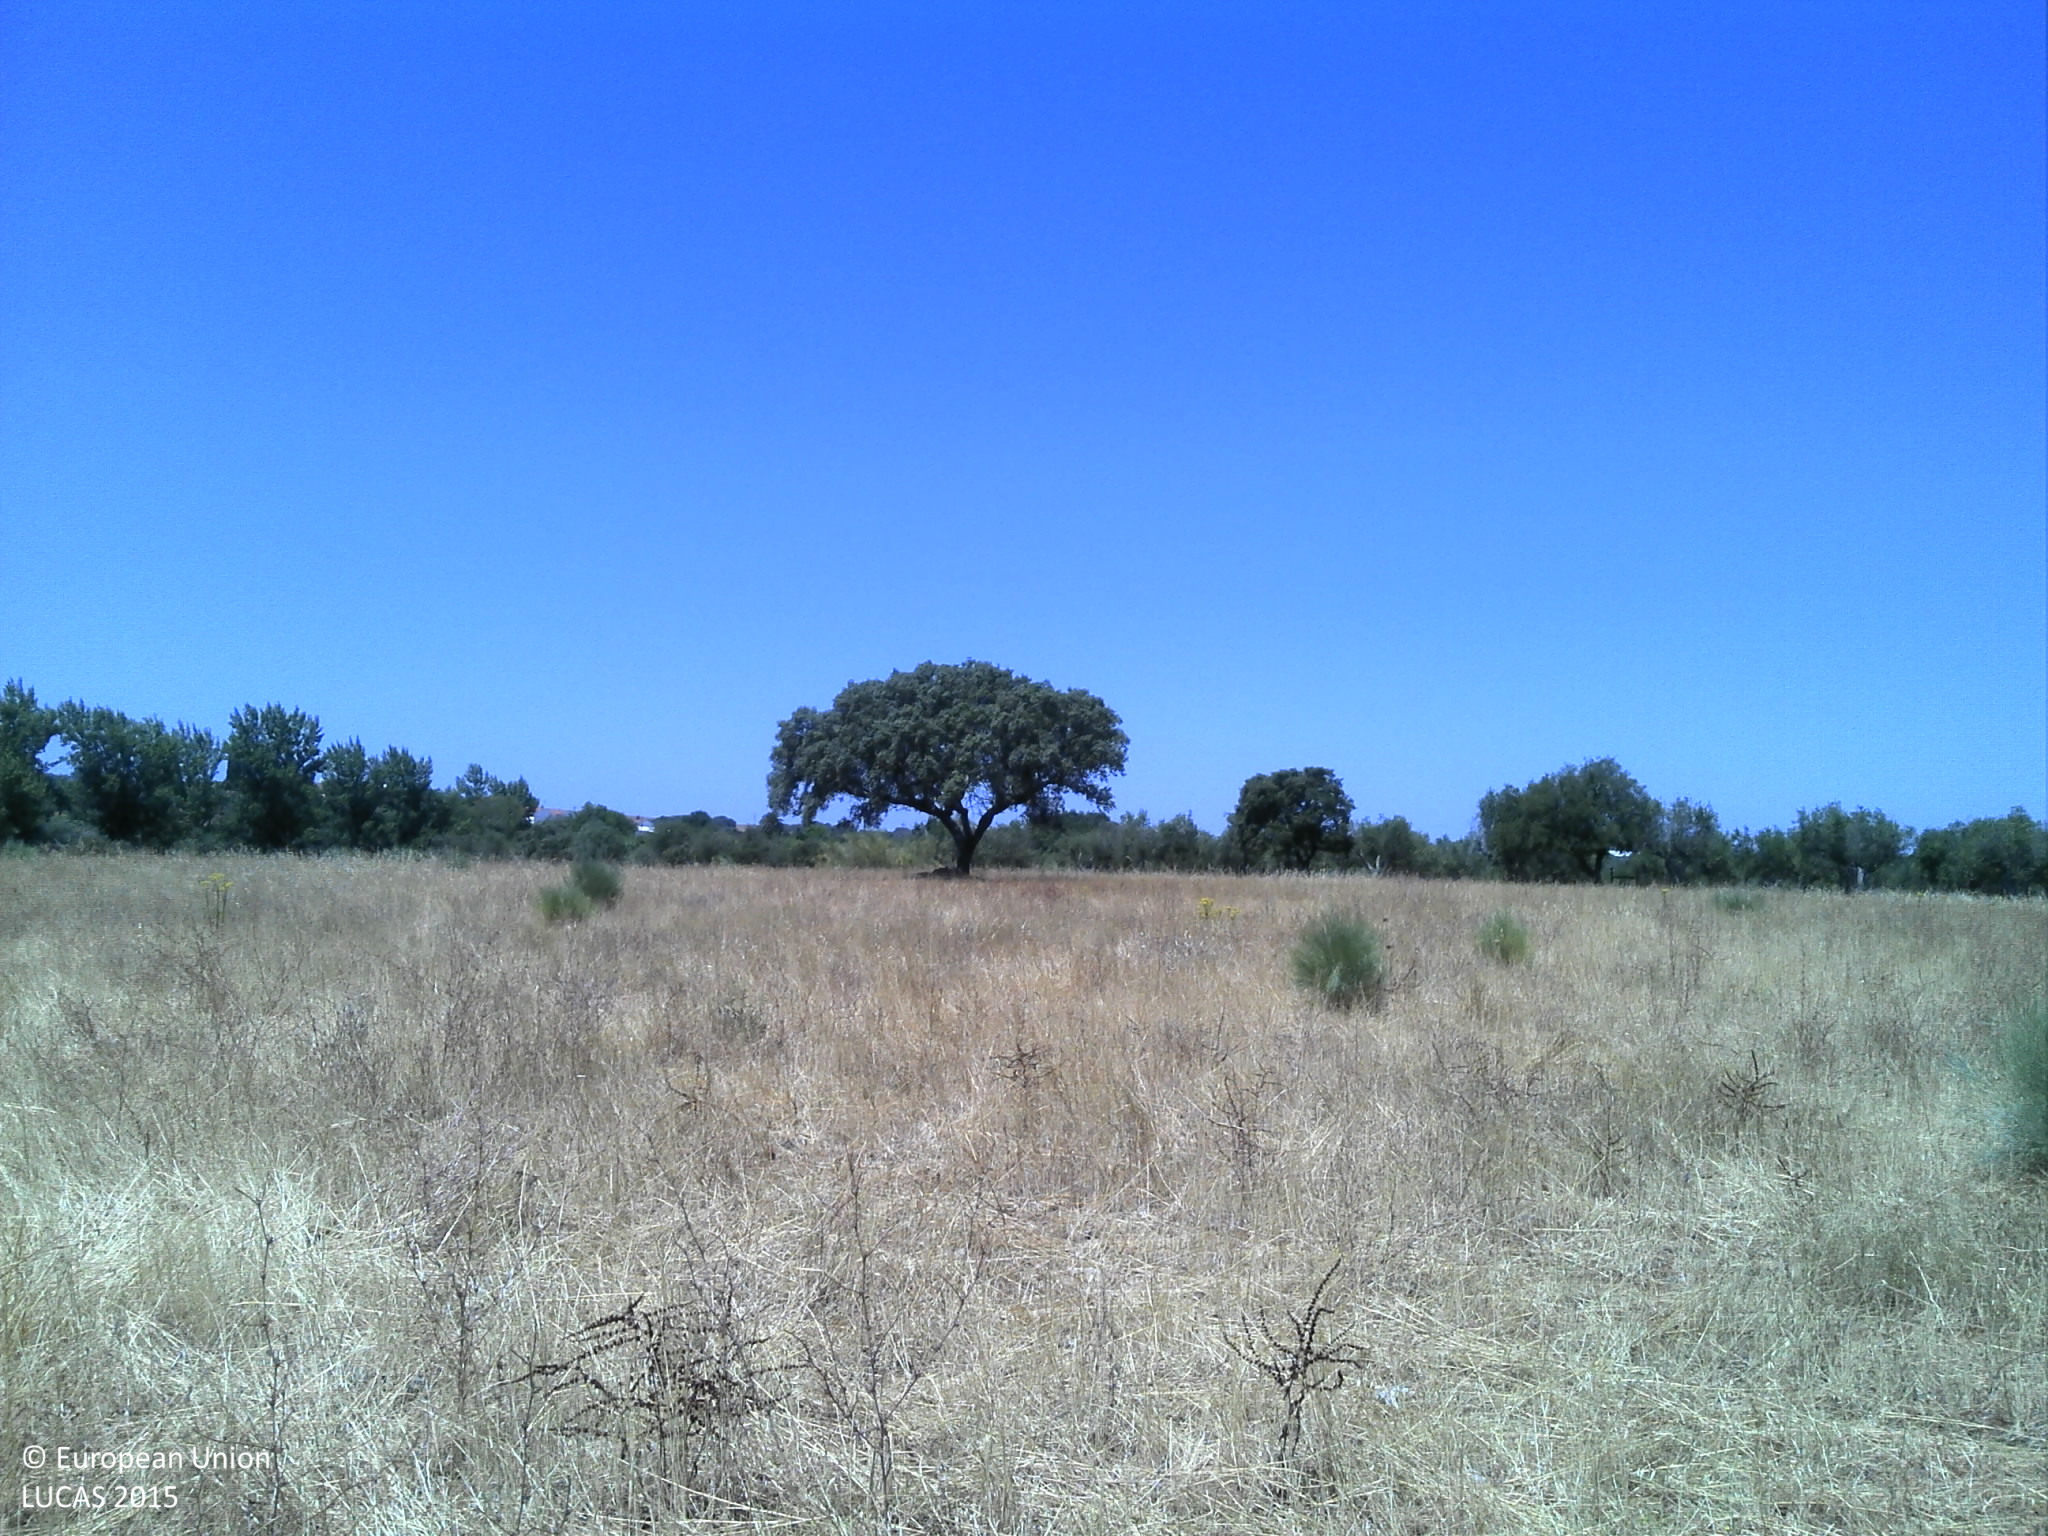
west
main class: Grassland
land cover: Grassland without tree/shrub cover
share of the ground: 50 - 75 %
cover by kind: herbaceous plants 75 %, unconsolidated bare surface 25 %
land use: Agriculture (excluding fallow land and kitchen gardens)
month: July
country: PT
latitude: 38.4665
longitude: -7.4593
